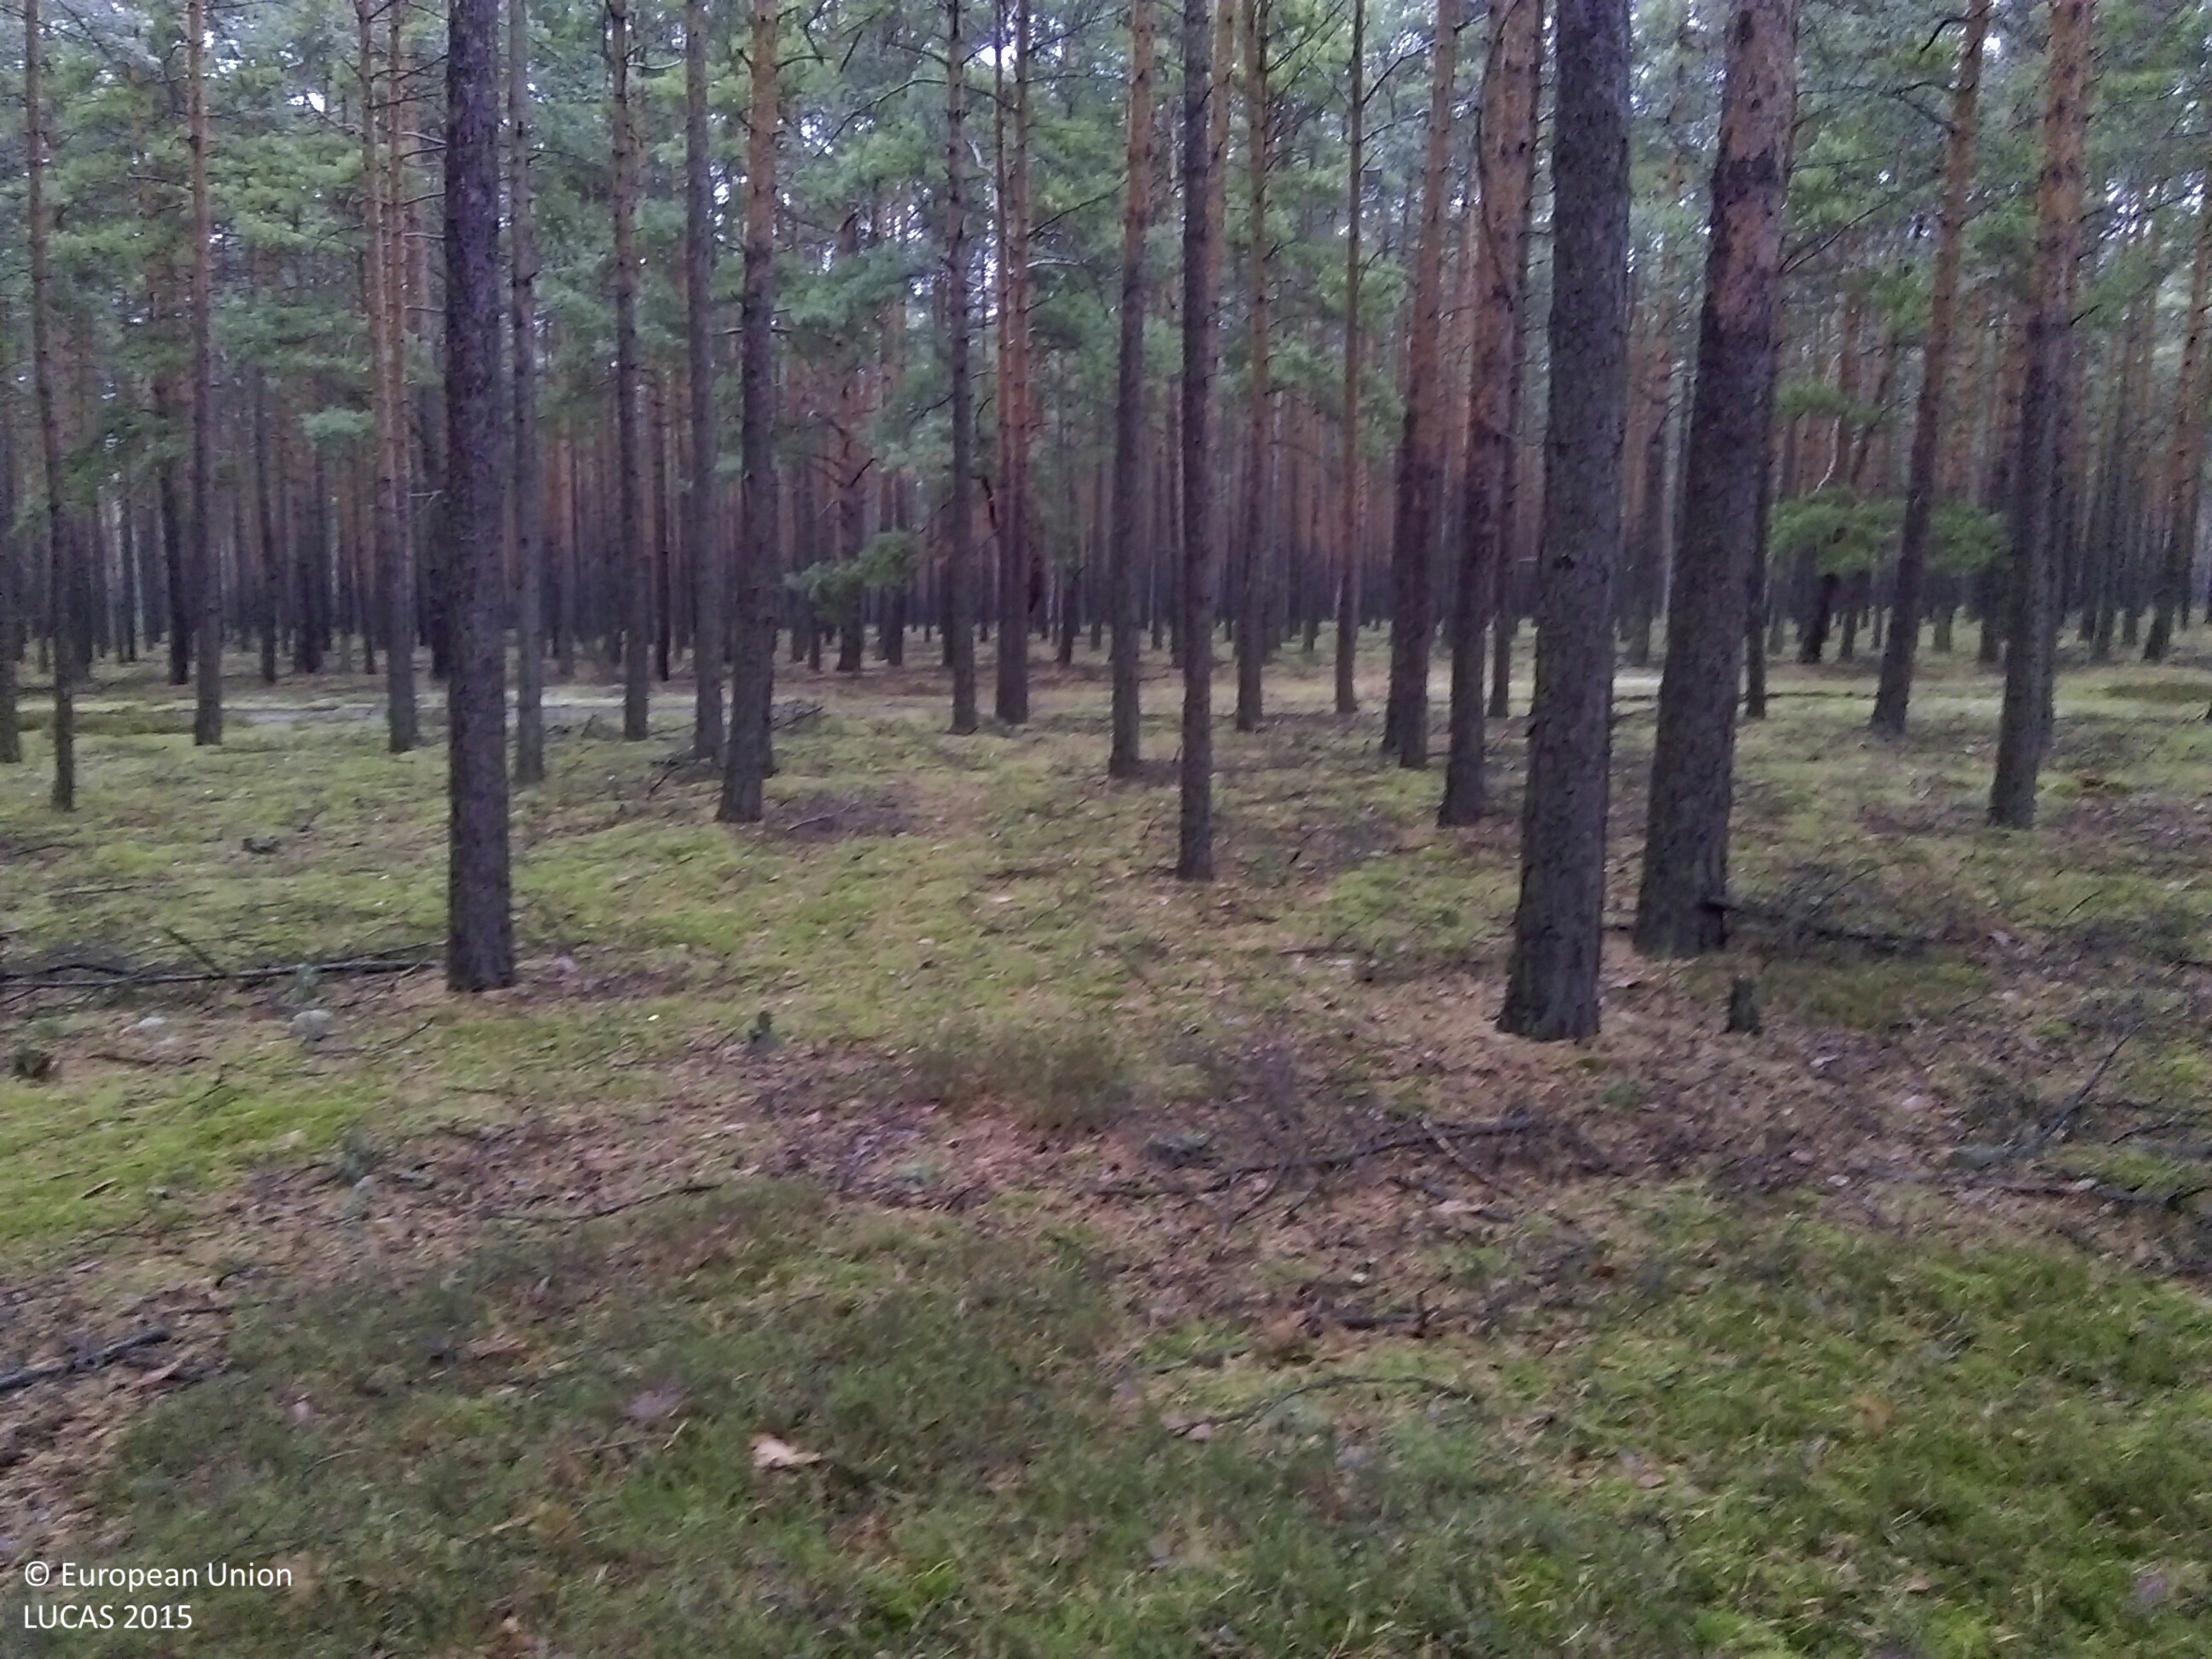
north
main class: Woodland
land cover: Pine dominated coniferous woodland
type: hemiboreal forest and nemoral coniferous forest and mixed broadleaved-coniferous forest
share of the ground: > 75 %
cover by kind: coniferous forest trees 85 %, lichens and mosses 15 %
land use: Forestry
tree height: > 5 m
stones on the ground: < 10 %
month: November
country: PL
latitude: 51.9581
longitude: 15.5778
